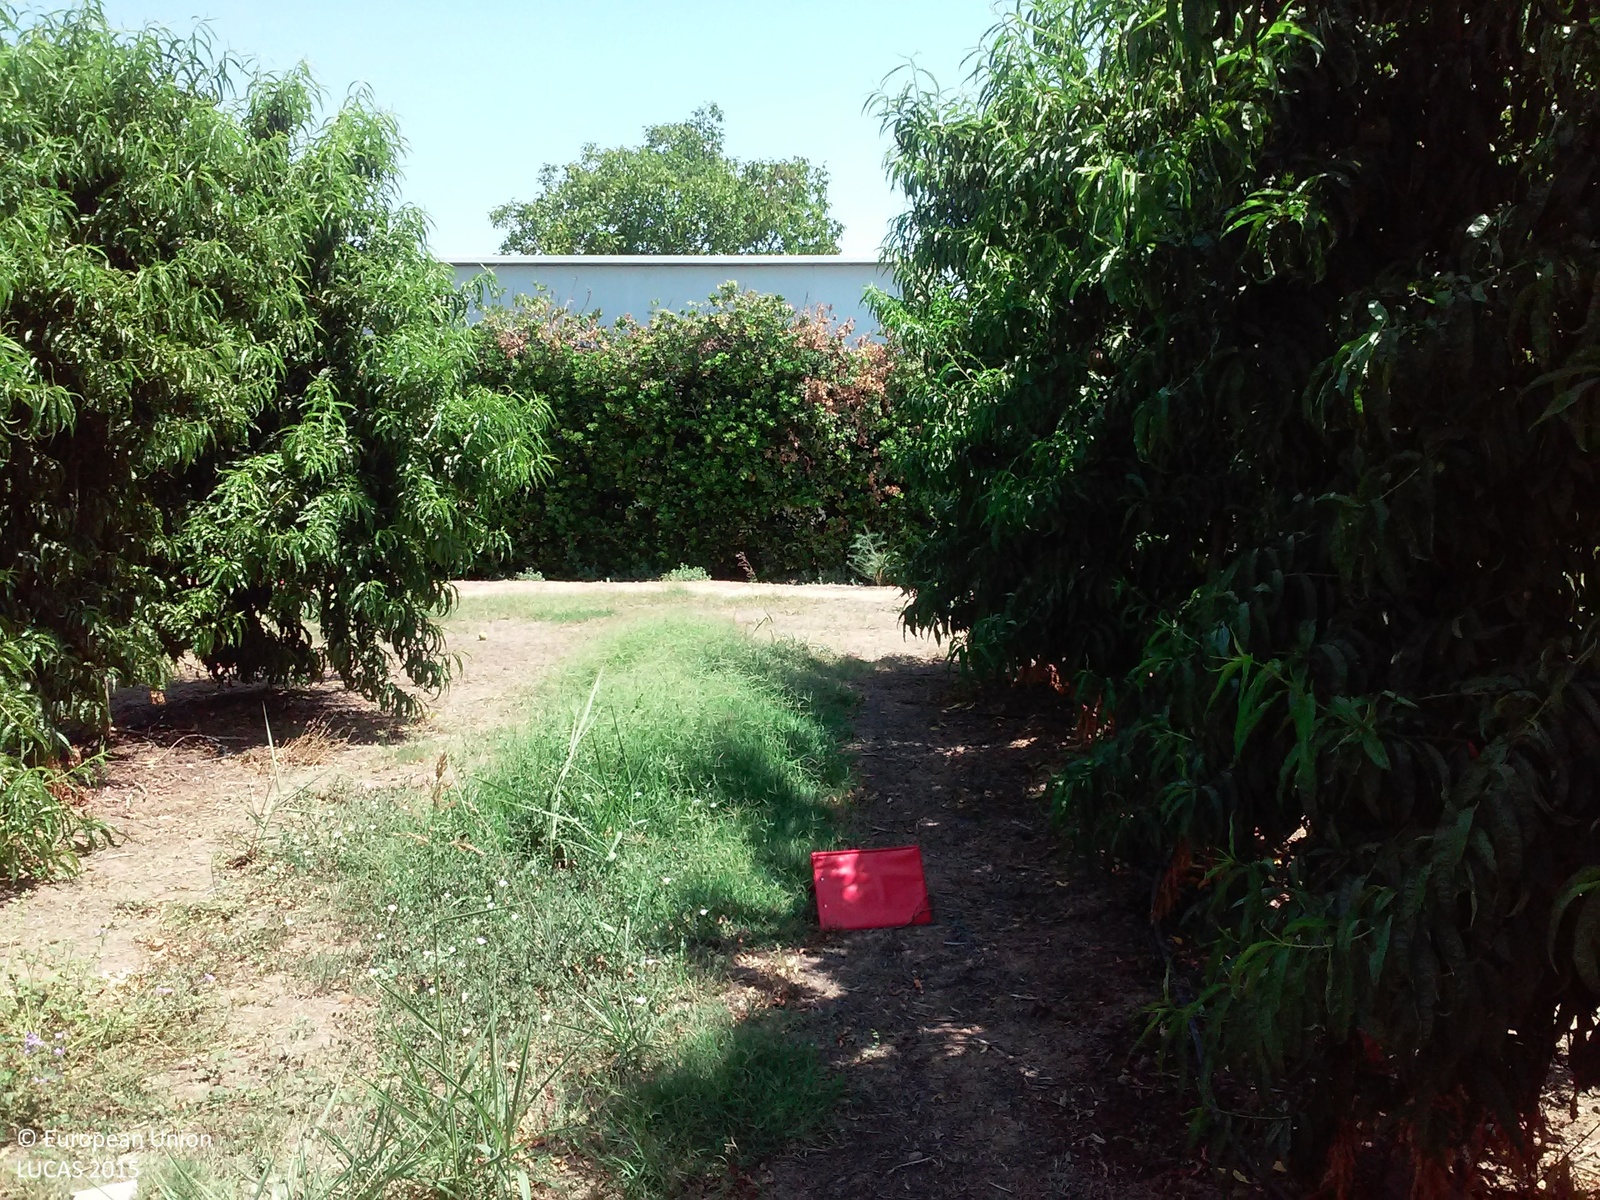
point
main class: Cropland
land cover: Other fruit trees and berries
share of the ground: 25 - 50 %
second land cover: Other bare soil
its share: > 75 %
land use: Agriculture (excluding fallow land and kitchen gardens)
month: July
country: ES
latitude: 41.6153
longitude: 0.5909
